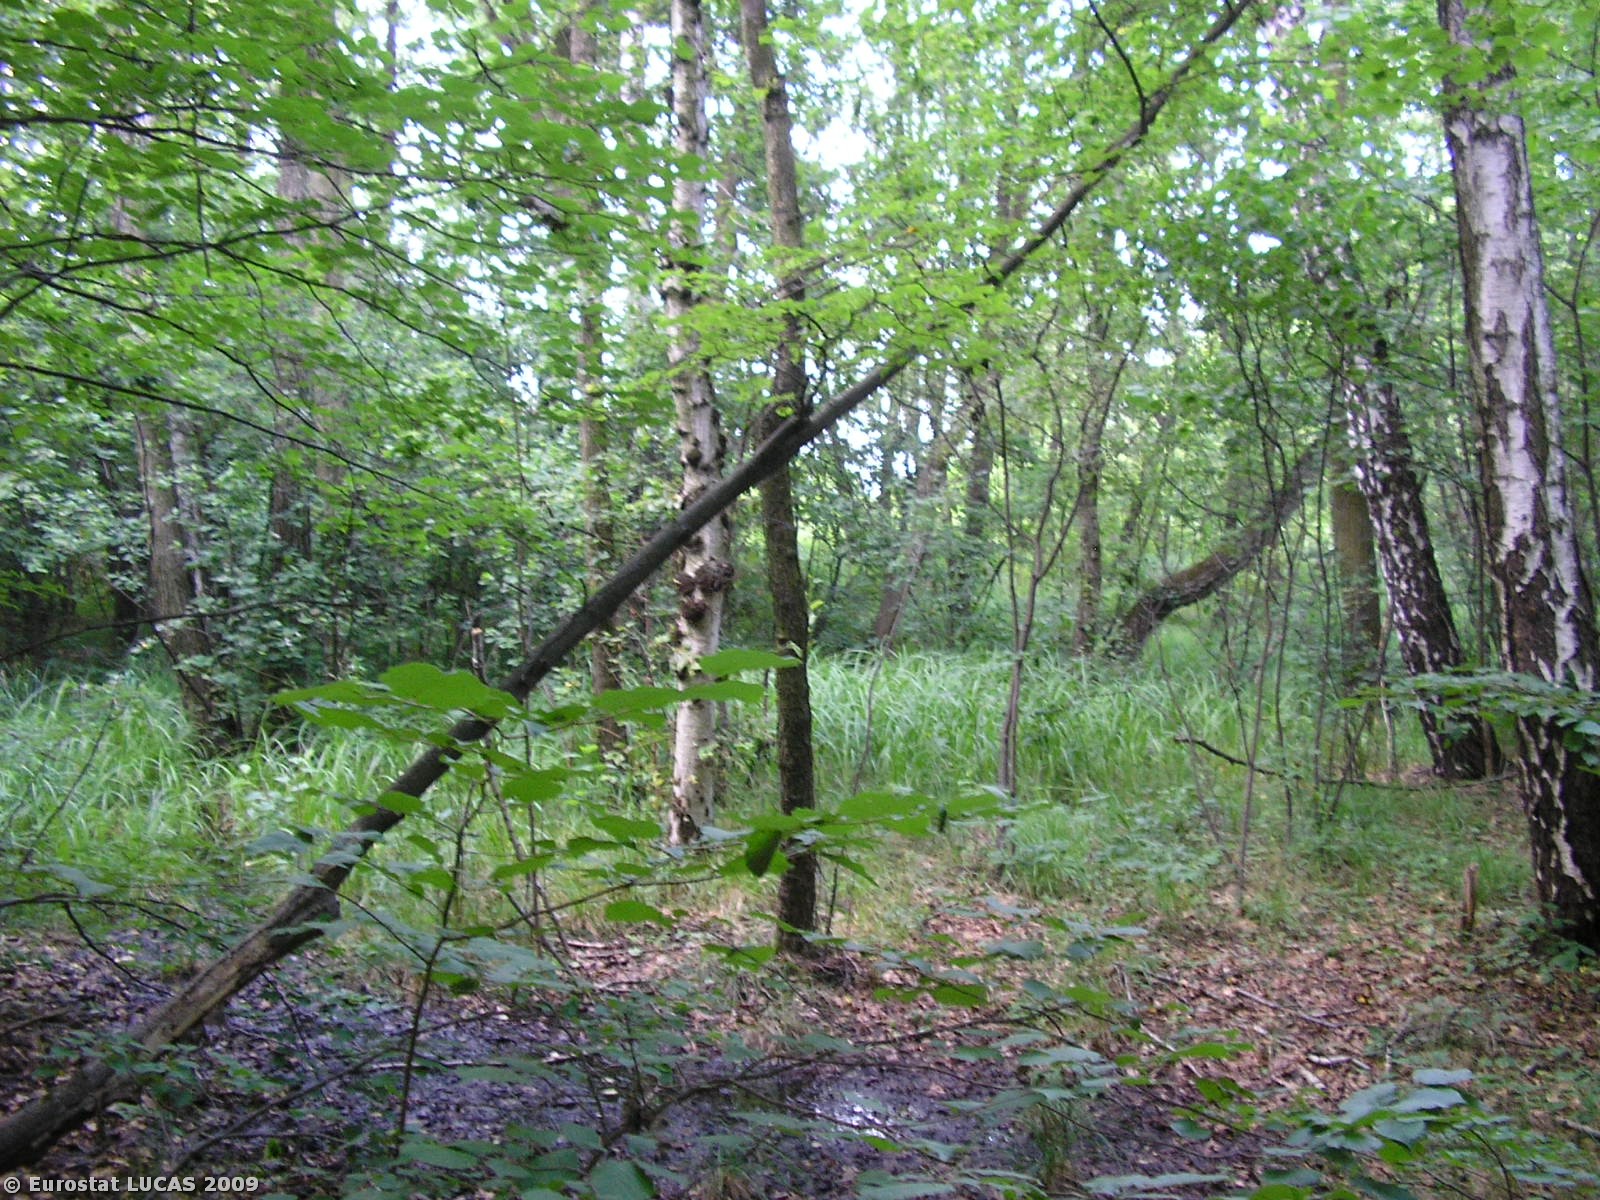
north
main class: Woodland
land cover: Broadleaved woodland
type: mesophytic deciduous forest
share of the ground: > 75 %
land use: Forestry
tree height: > 5 m
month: June
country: PL
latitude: 50.3879
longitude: 20.6873
